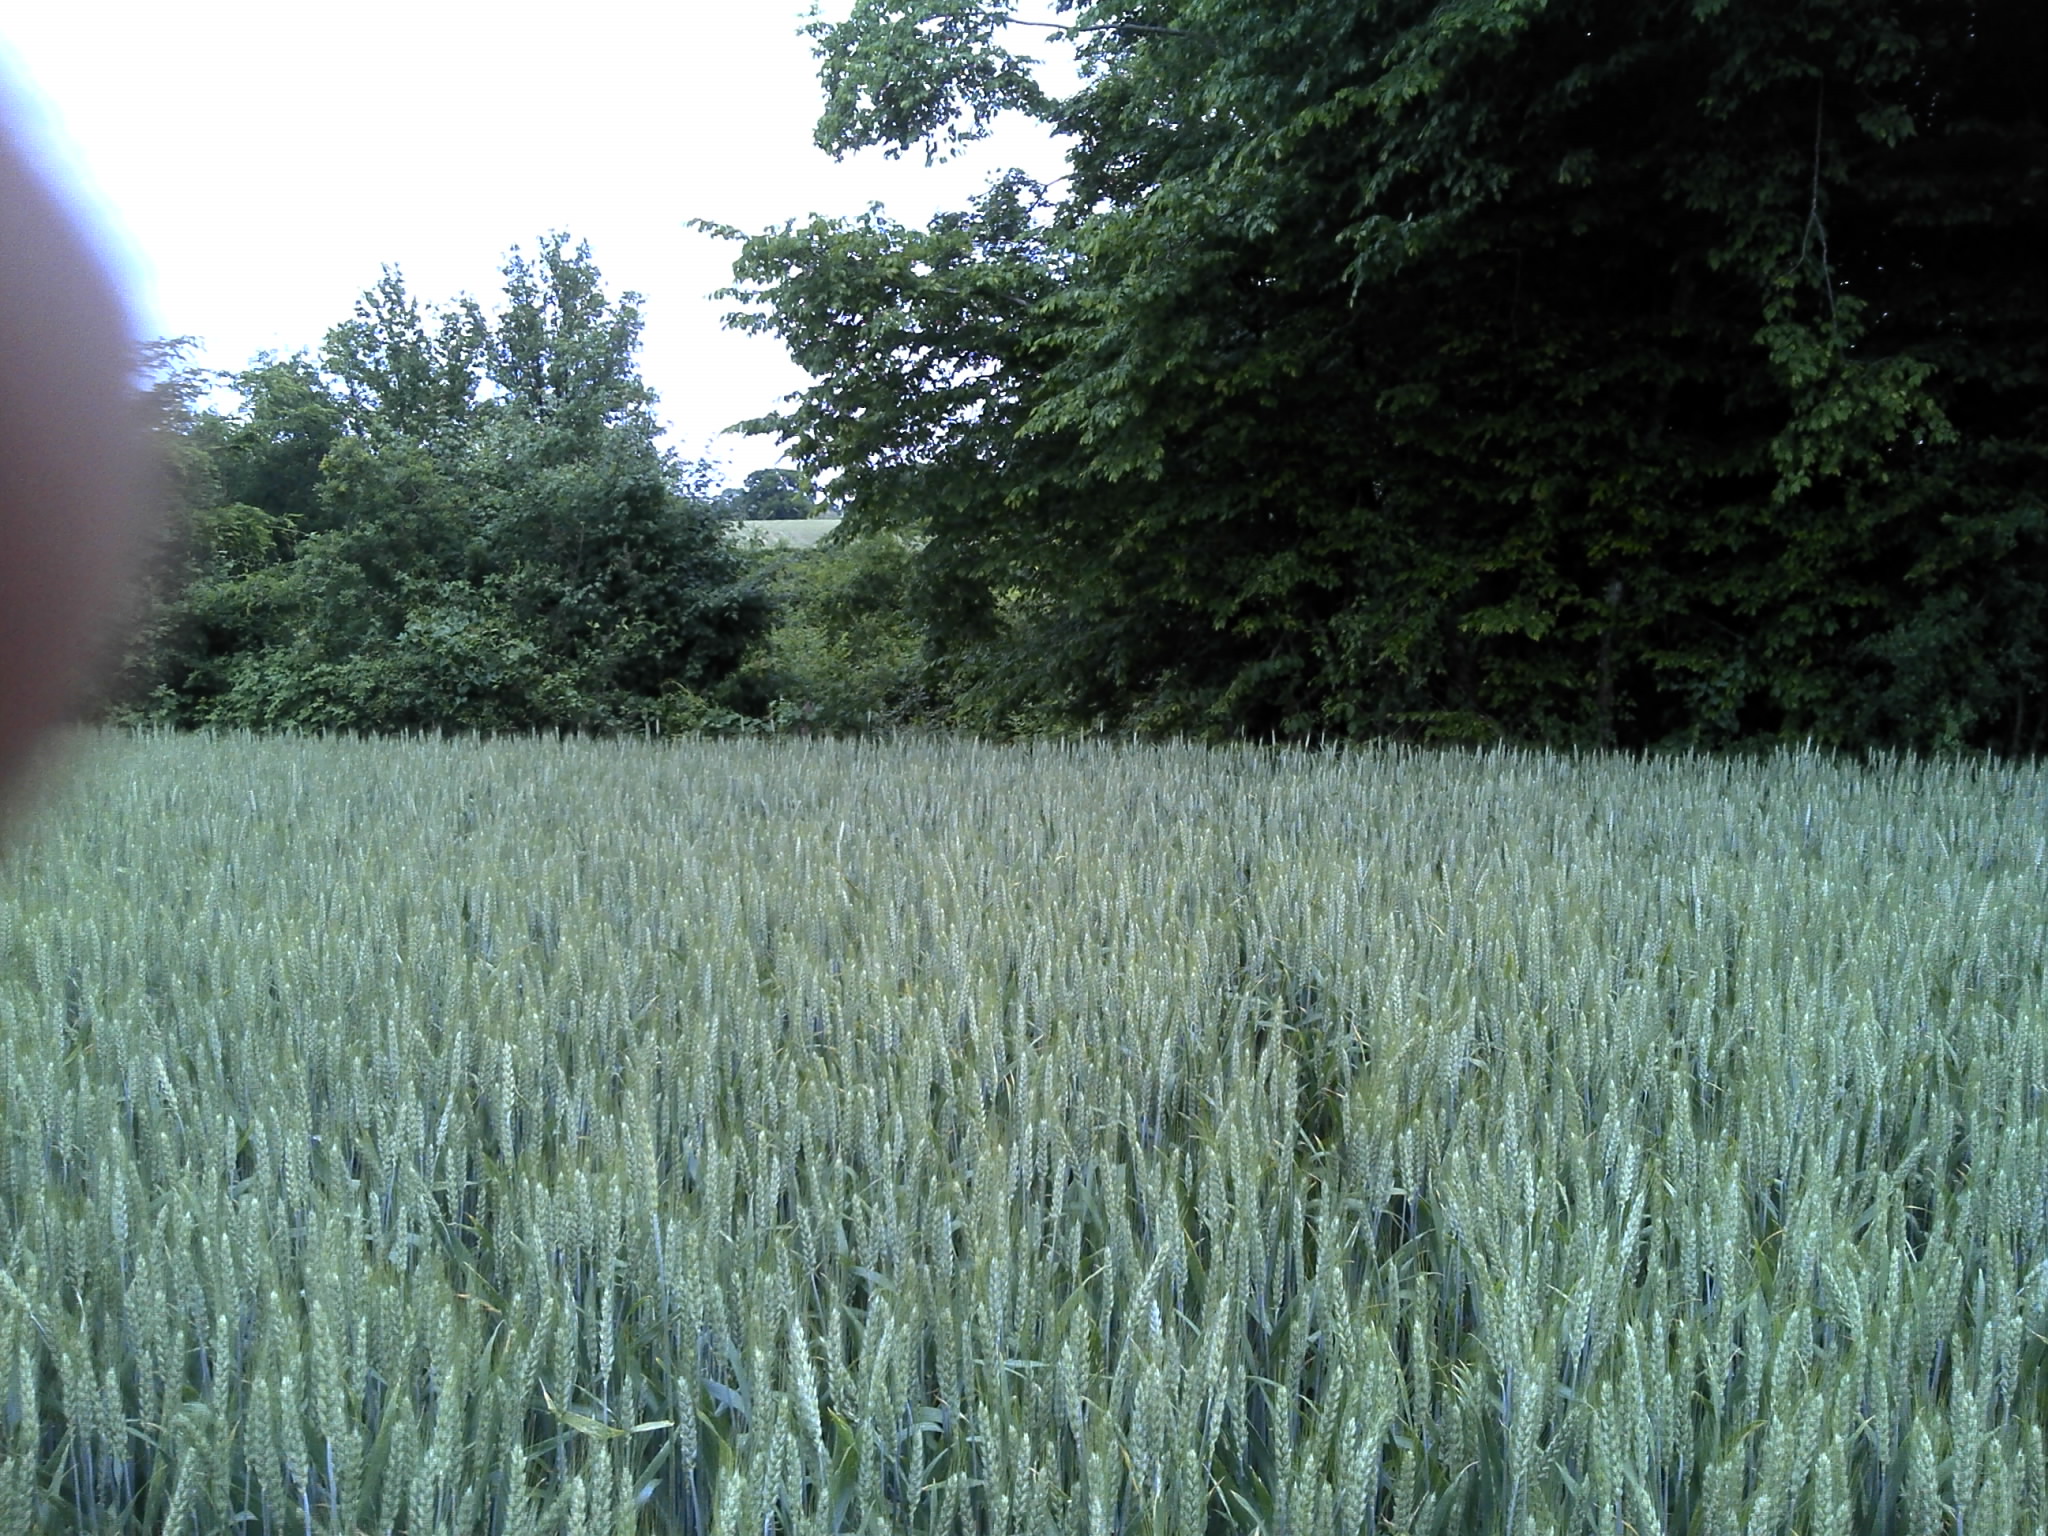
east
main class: Cropland
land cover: Common wheat
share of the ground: > 75 %
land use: Agriculture (excluding fallow land and kitchen gardens)
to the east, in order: Common wheat; Grass margins; Broadleaved woodland; Paved roads, cycling and walking lanes; Grass margins; Broadleaved woodland; Ditches and canals; Grassland without tree/shrub cover
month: May
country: FR
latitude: 46.5912
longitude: 1.4924
